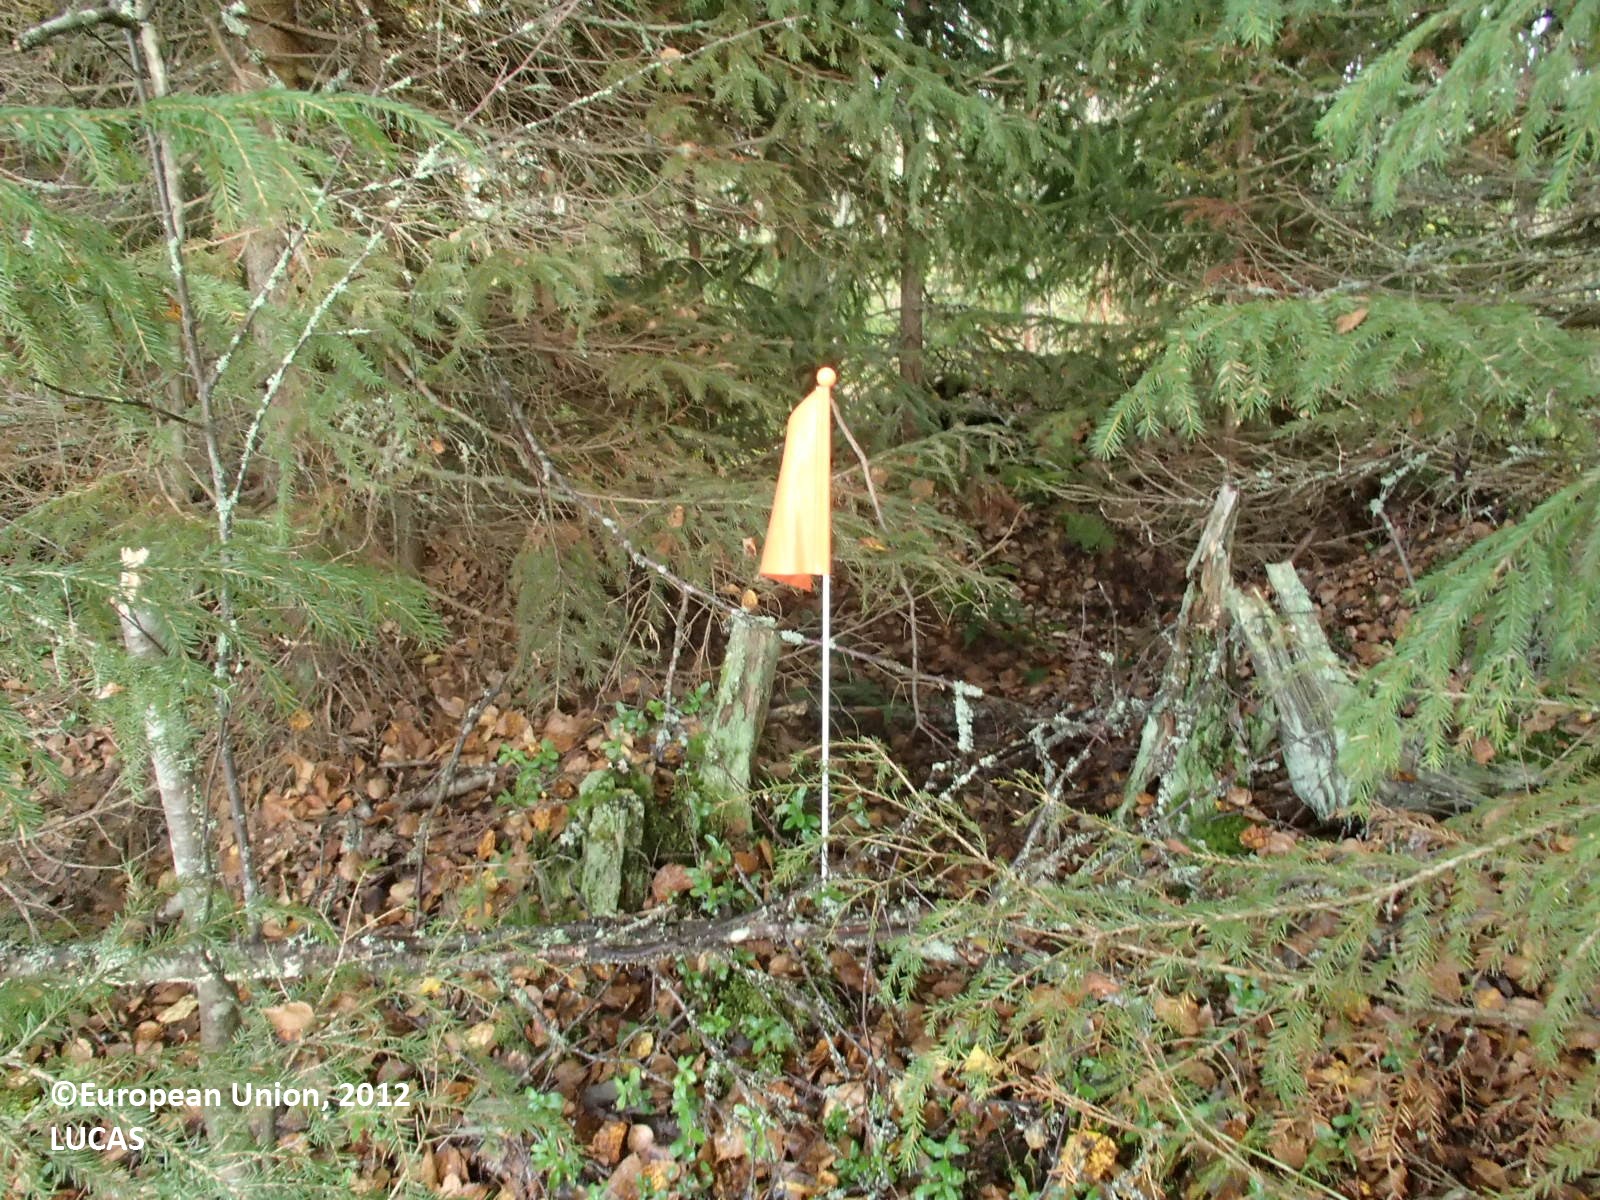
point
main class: Woodland
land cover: Spruce dominated mixed woodland
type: boreal forest
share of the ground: > 75 %
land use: Forestry
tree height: > 5 m
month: September
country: FI
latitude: 63.3448
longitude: 27.7682
